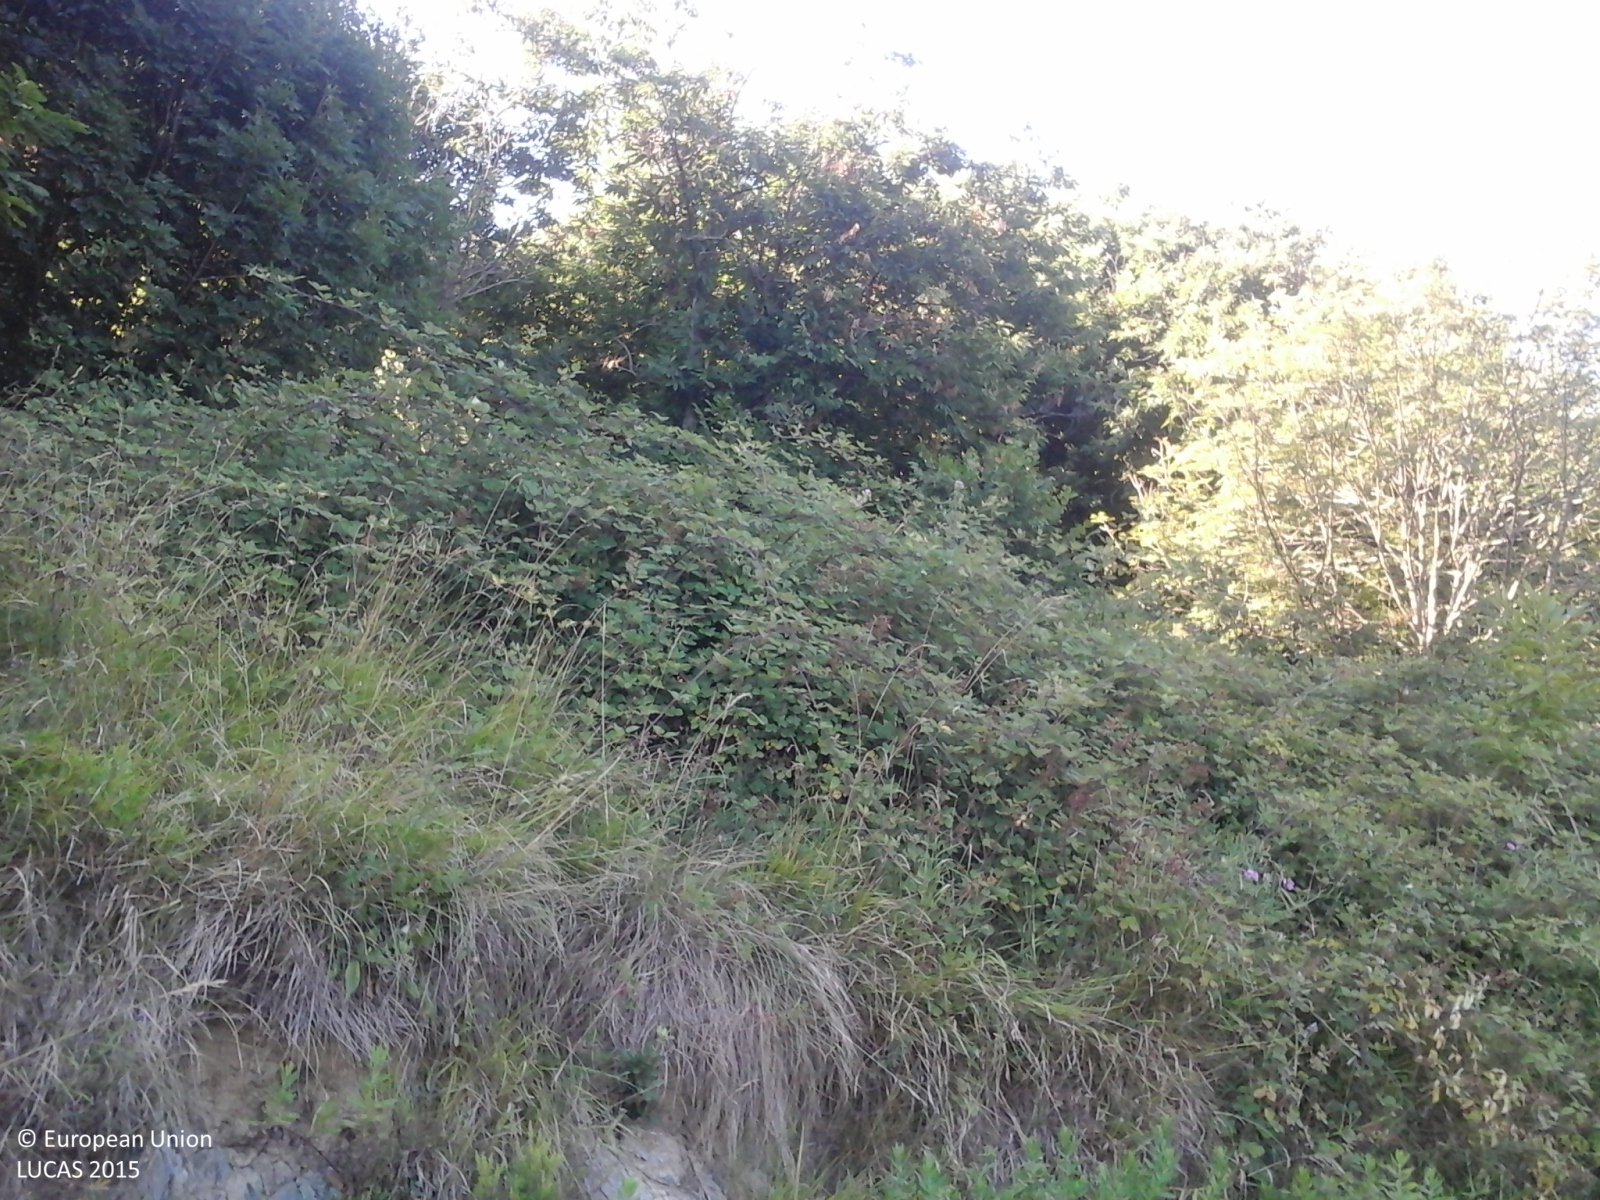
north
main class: Woodland
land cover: Broadleaved woodland
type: thermophilous deciduous forest
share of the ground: > 75 %
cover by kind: broadleaved forest trees 80 %, shrubs 10 %, coniferous forest trees 5 %, herbaceous plants 5 %
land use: Semi-natural and natural areas not in use
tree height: > 5 m
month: August
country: IT
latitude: 44.4688
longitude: 8.7081
